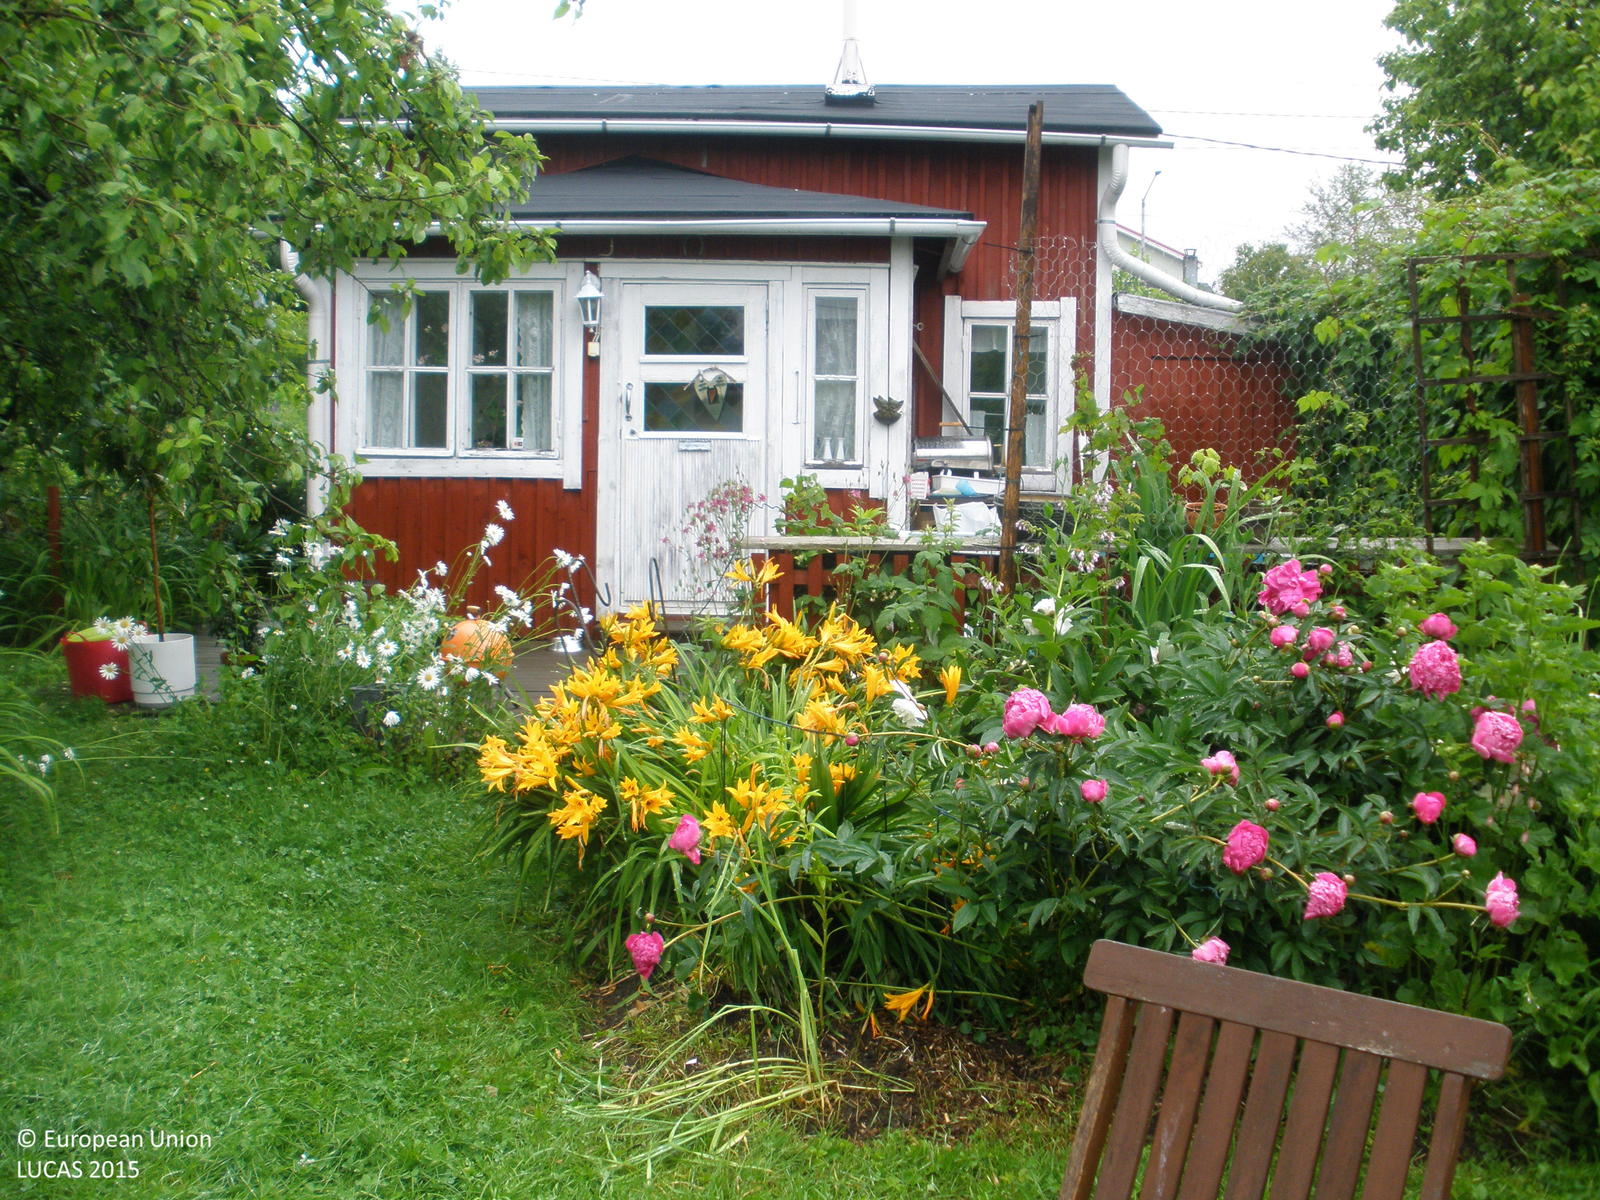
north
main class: Cropland
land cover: Floriculture and ornamental plants
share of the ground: > 75 %
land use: Amenities, museums, leisure
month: July
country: FI
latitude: 61.4766
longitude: 23.8079
